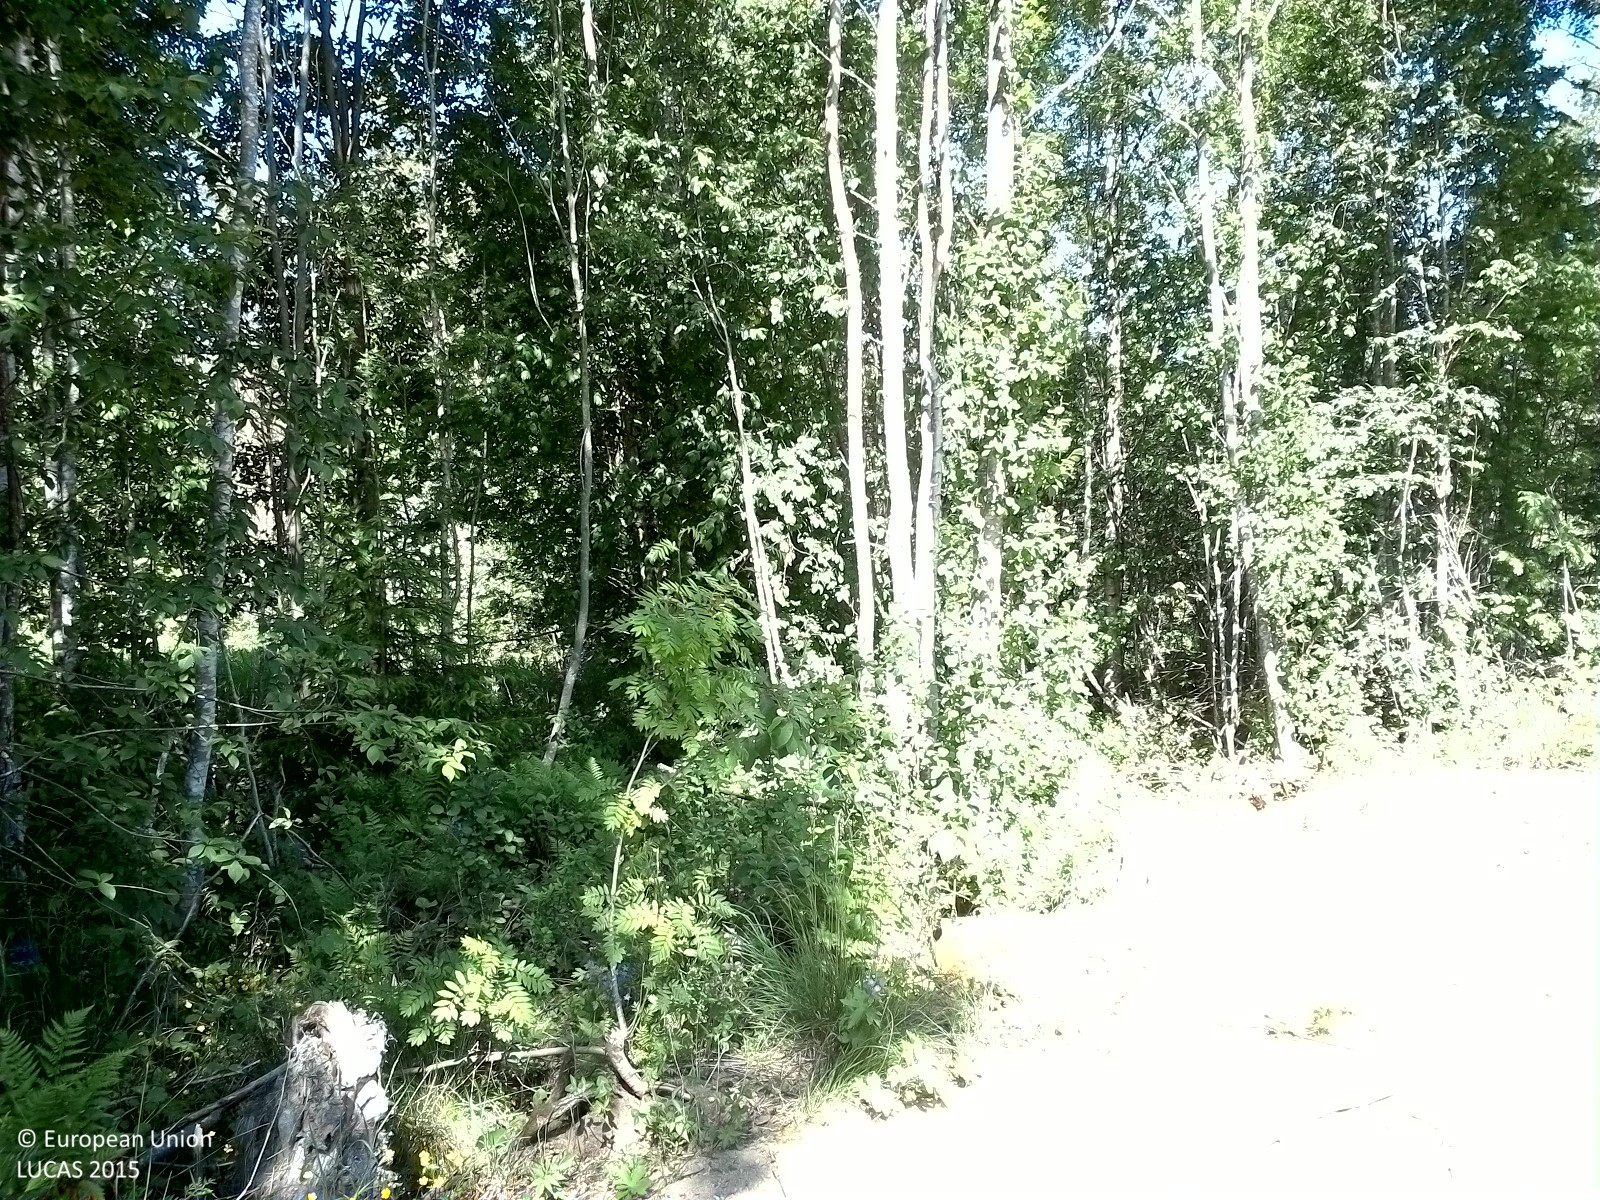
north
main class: Woodland
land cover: Broadleaved woodland
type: boreal forest
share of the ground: 50 - 75 %
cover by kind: broadleaved forest trees 70 %, herbaceous plants 30 %
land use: Semi-natural and natural areas not in use
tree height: > 5 m
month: July
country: SE
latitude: 62.2732
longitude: 16.8973
